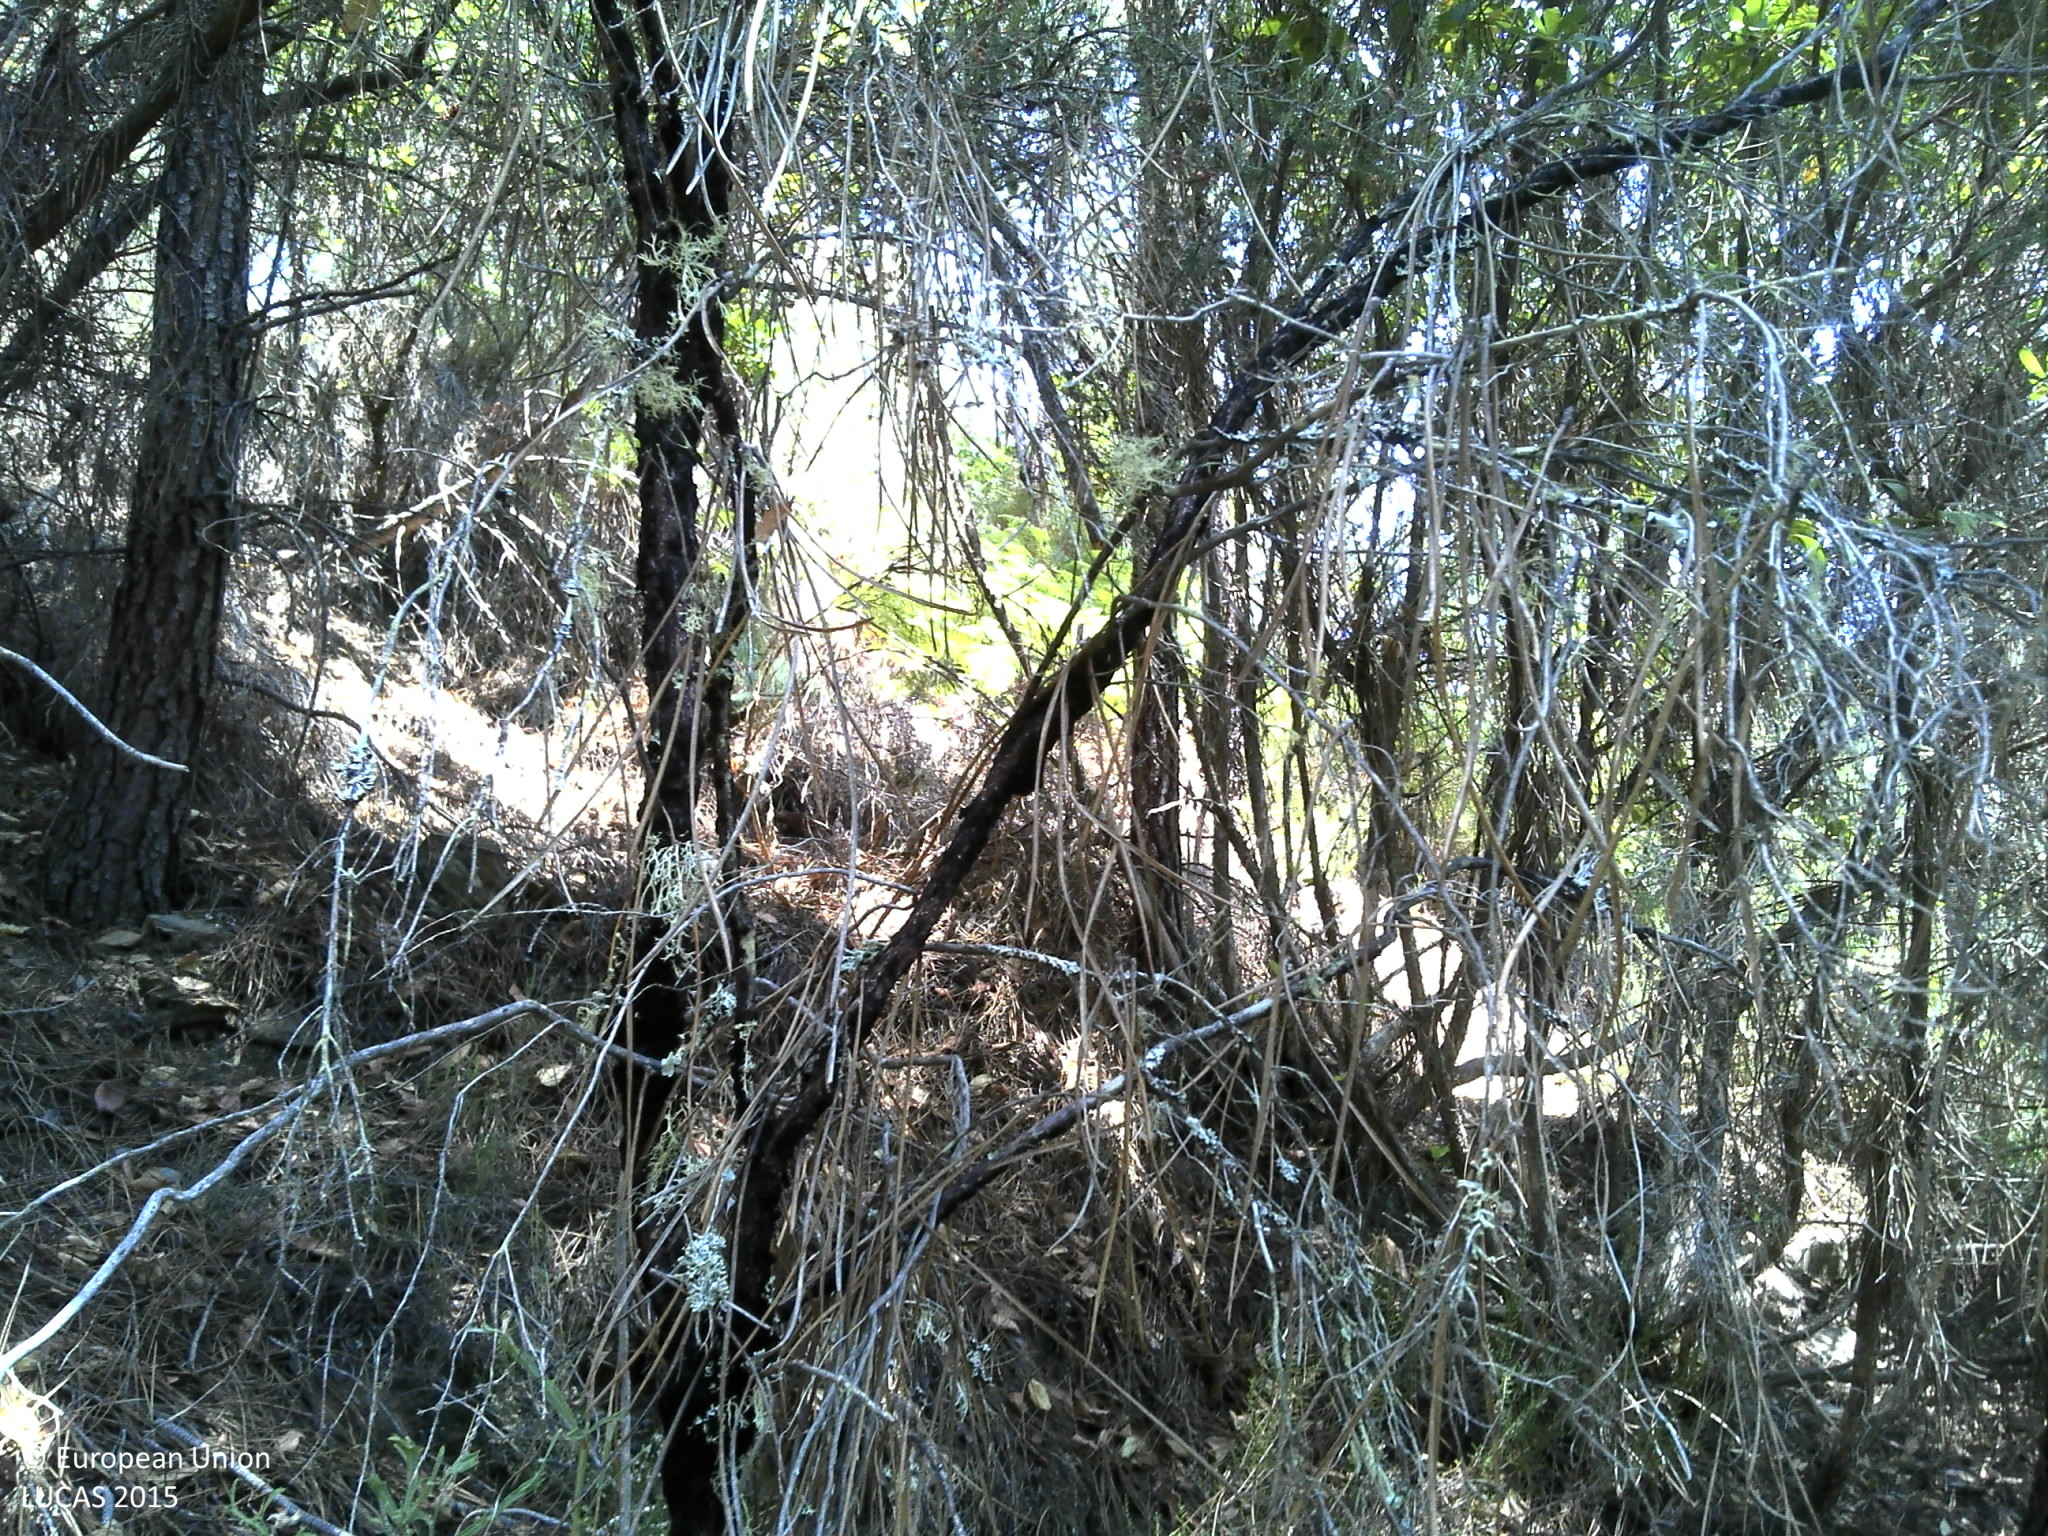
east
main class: Woodland
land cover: Pine dominated coniferous woodland
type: coniferous forest of the mediterranean region
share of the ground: 25 - 50 %
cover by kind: shrubs 50 %, coniferous forest trees 35 %, unconsolidated bare surface 15 %
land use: Forestry
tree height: > 5 m
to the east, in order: Pine dominated coniferous woodland; Broadleaved woodland; Tracks; Broadleaved woodland; Tracks; Pine dominated mixed woodland; Broadleaved woodland; Tracks; Broadleaved woodland; Pine dominated coniferous woodland
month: June
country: PT
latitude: 40.0182
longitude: -8.0546
